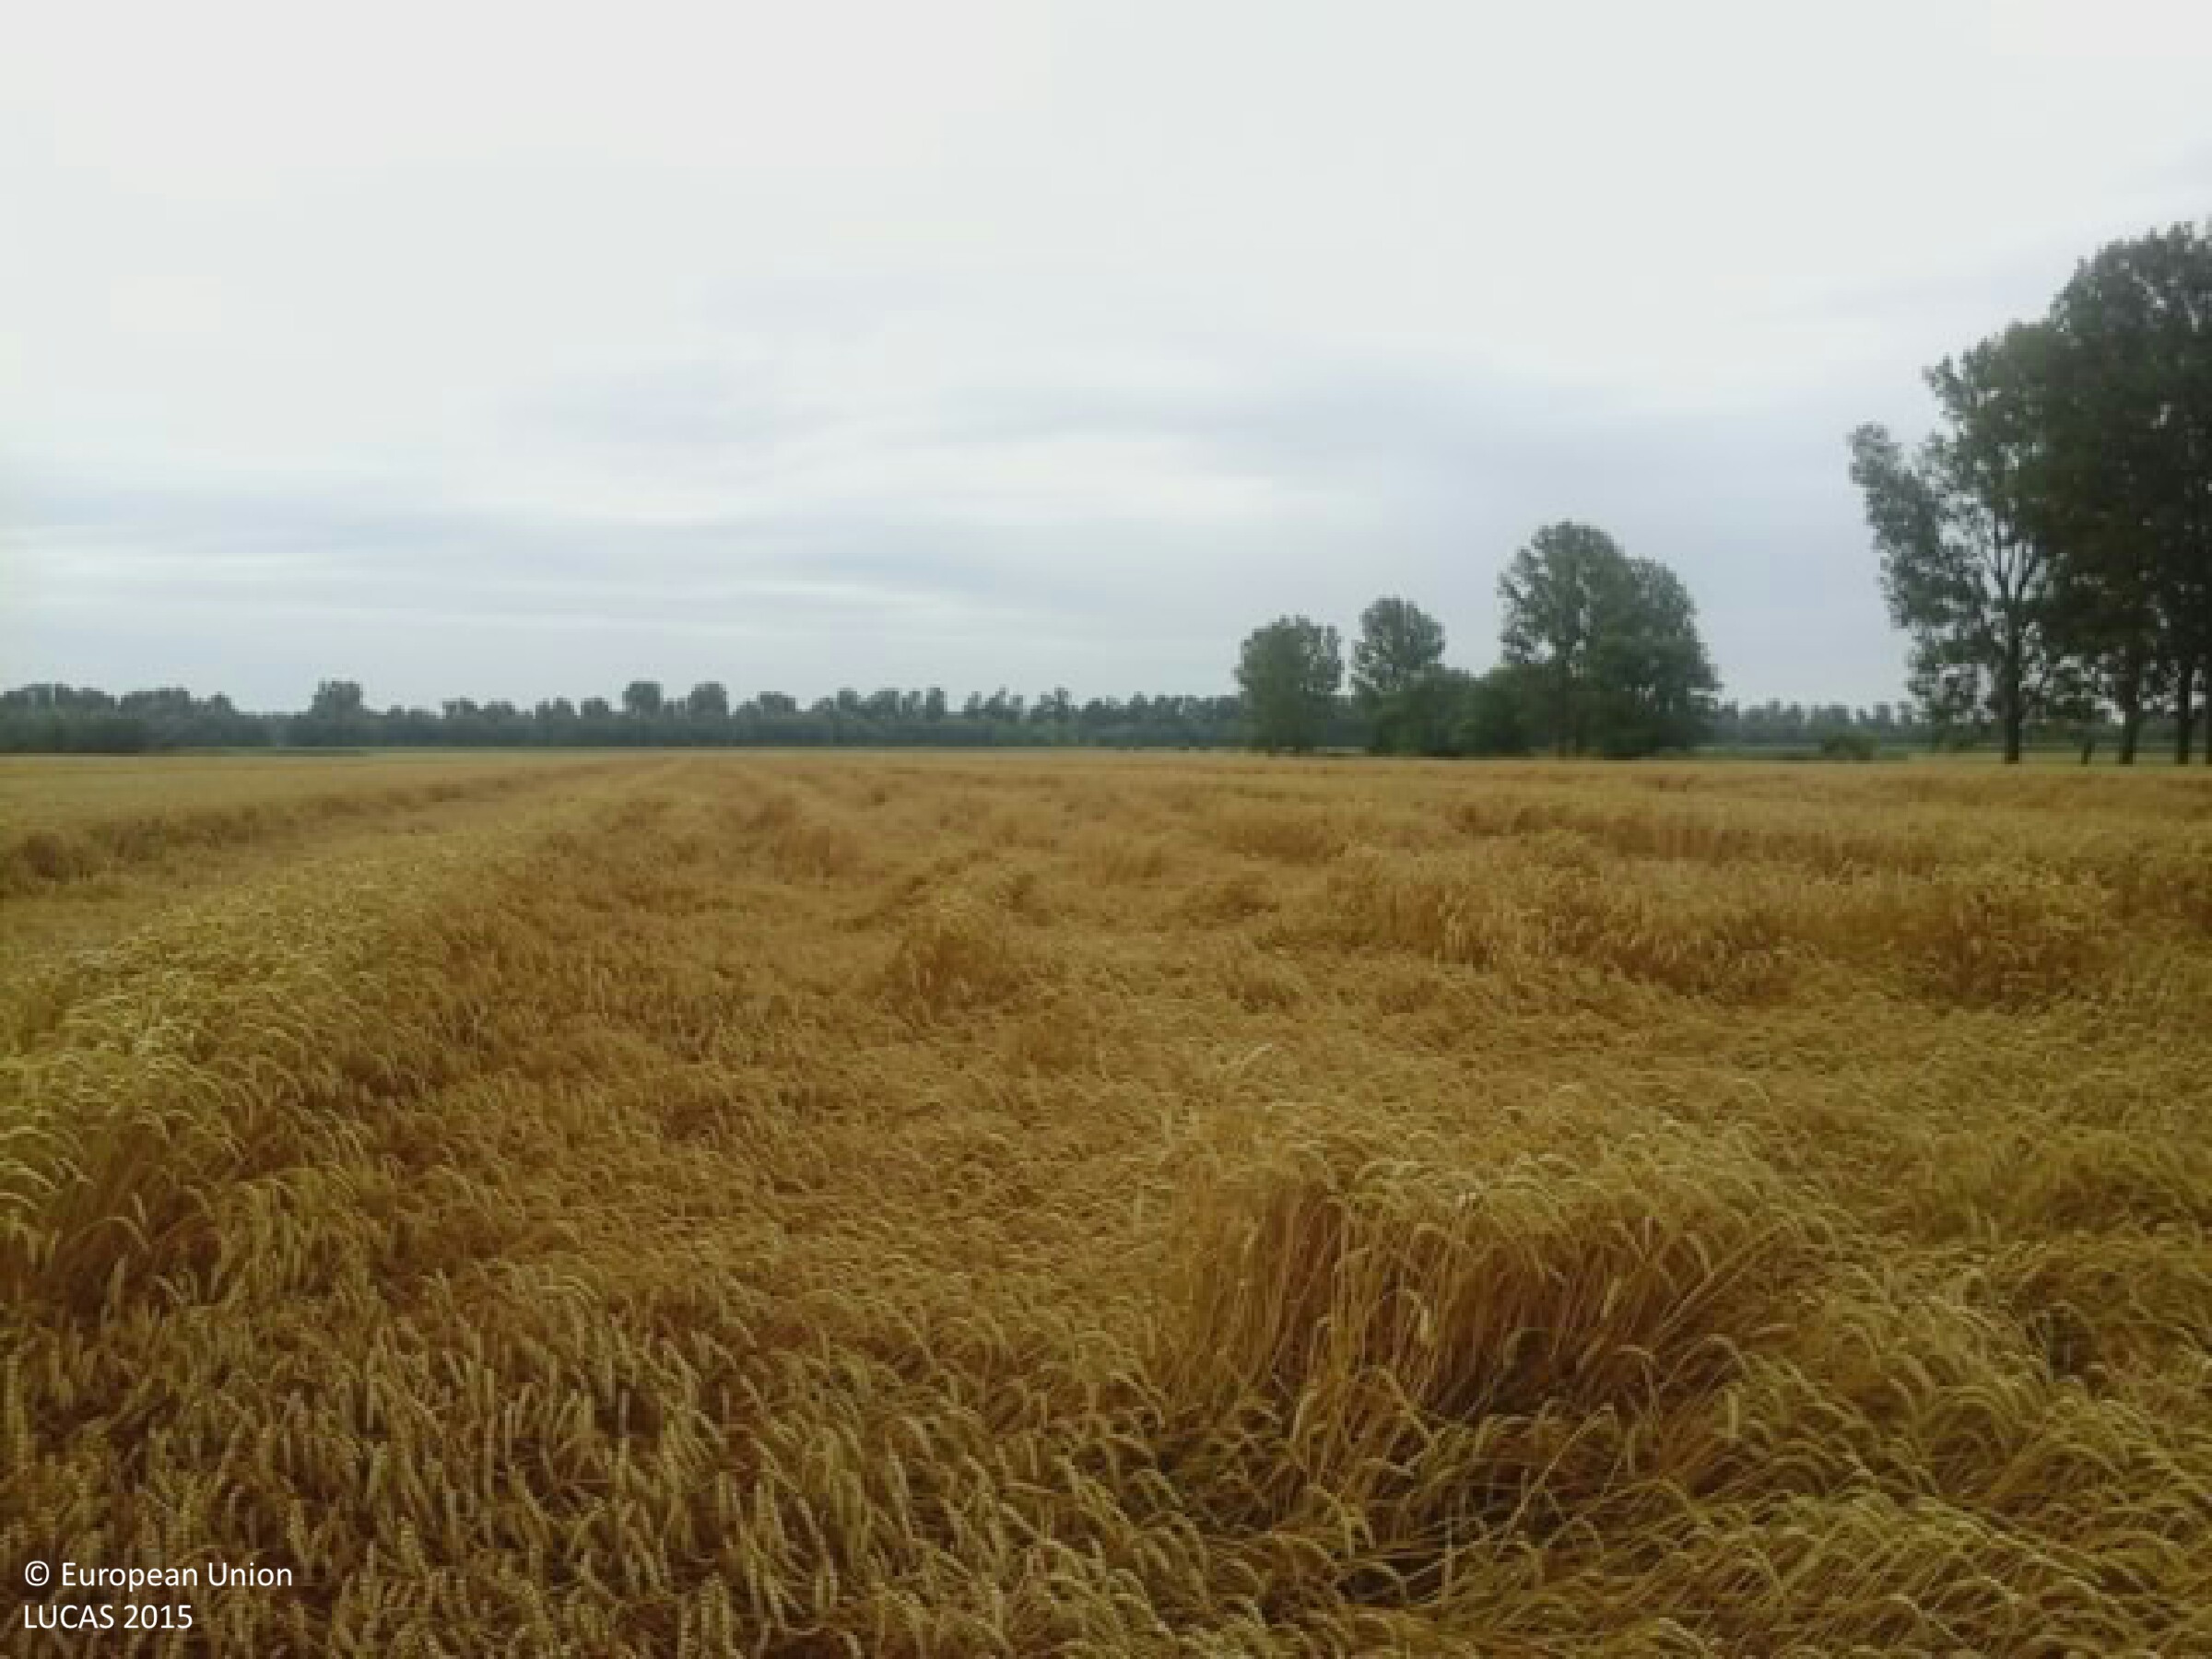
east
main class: Cropland
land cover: Common wheat
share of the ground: > 75 %
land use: Agriculture (excluding fallow land and kitchen gardens)
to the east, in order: Common wheat
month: July
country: HU
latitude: 46.5060
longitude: 18.8874
